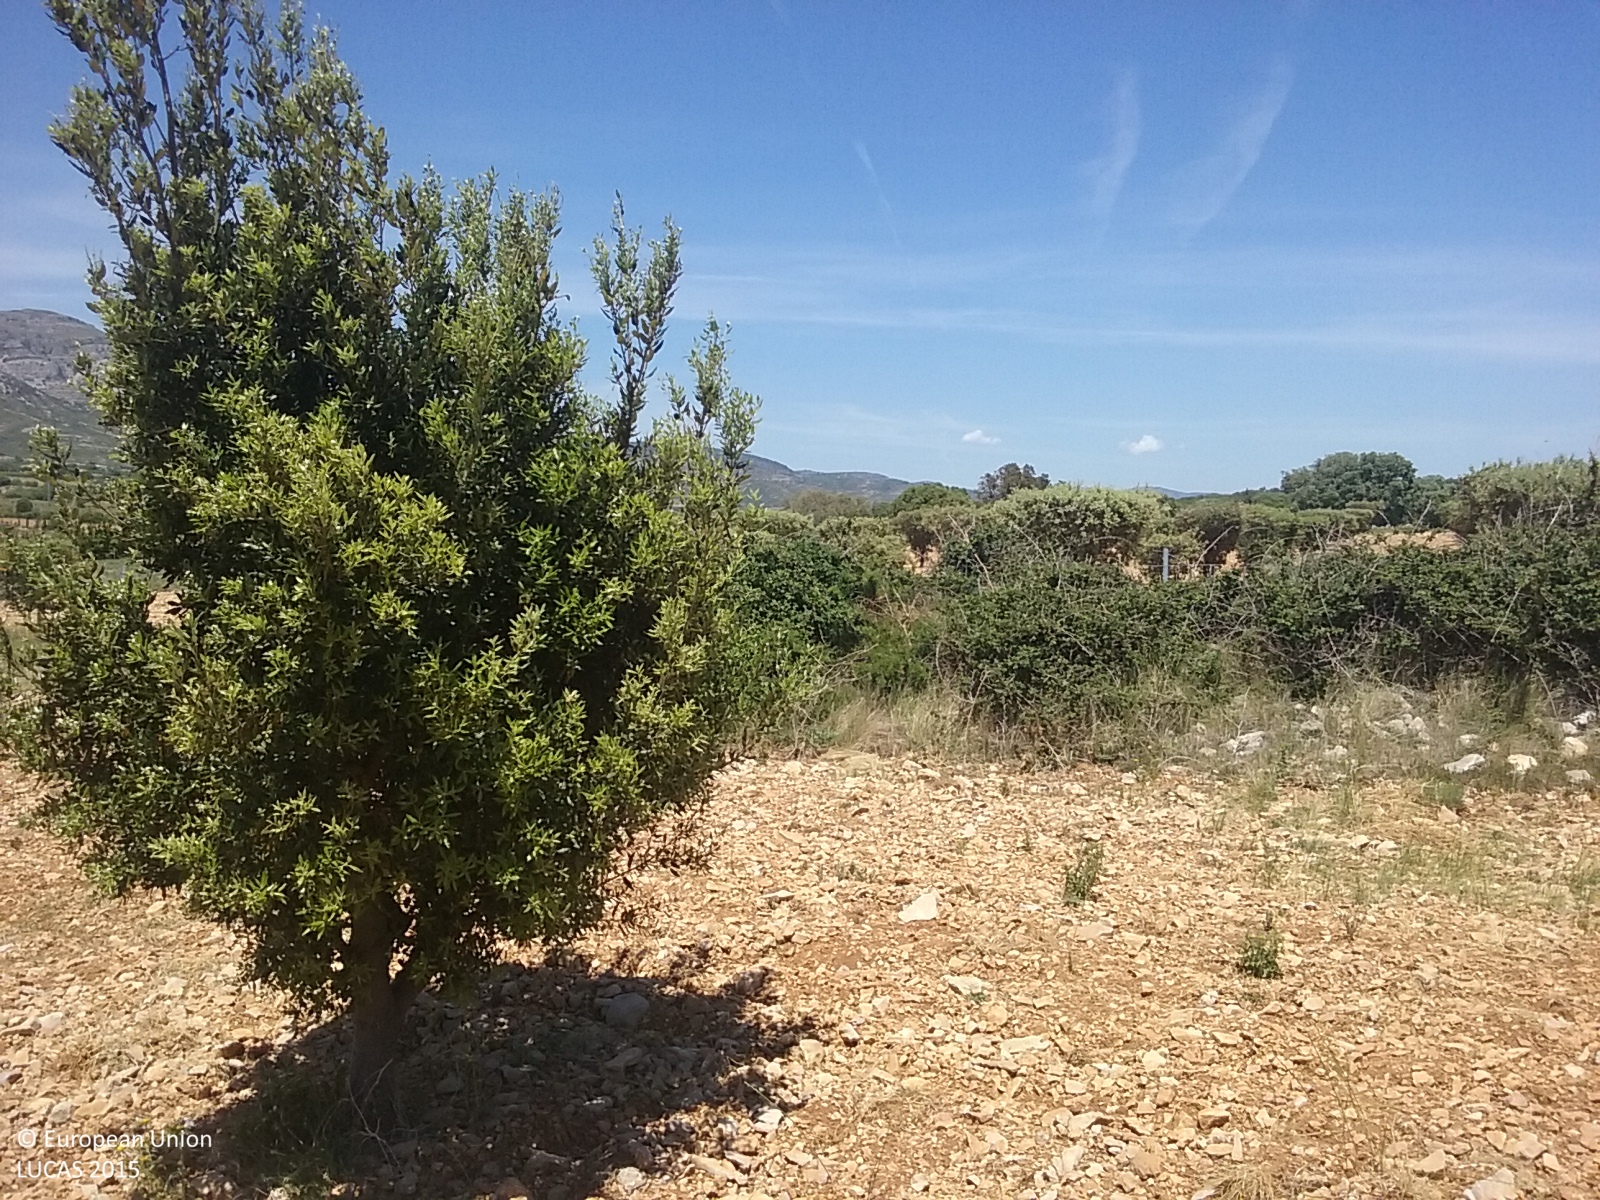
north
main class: Woodland
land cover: Broadleaved woodland
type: broadleaved evergreen forest
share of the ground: 10 - 25 %
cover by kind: unconsolidated bare surface 85 %, broadleaved forest trees 15 %
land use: Forestry
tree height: < 5 m
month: May
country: ES
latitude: 40.4279
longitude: -0.0124
